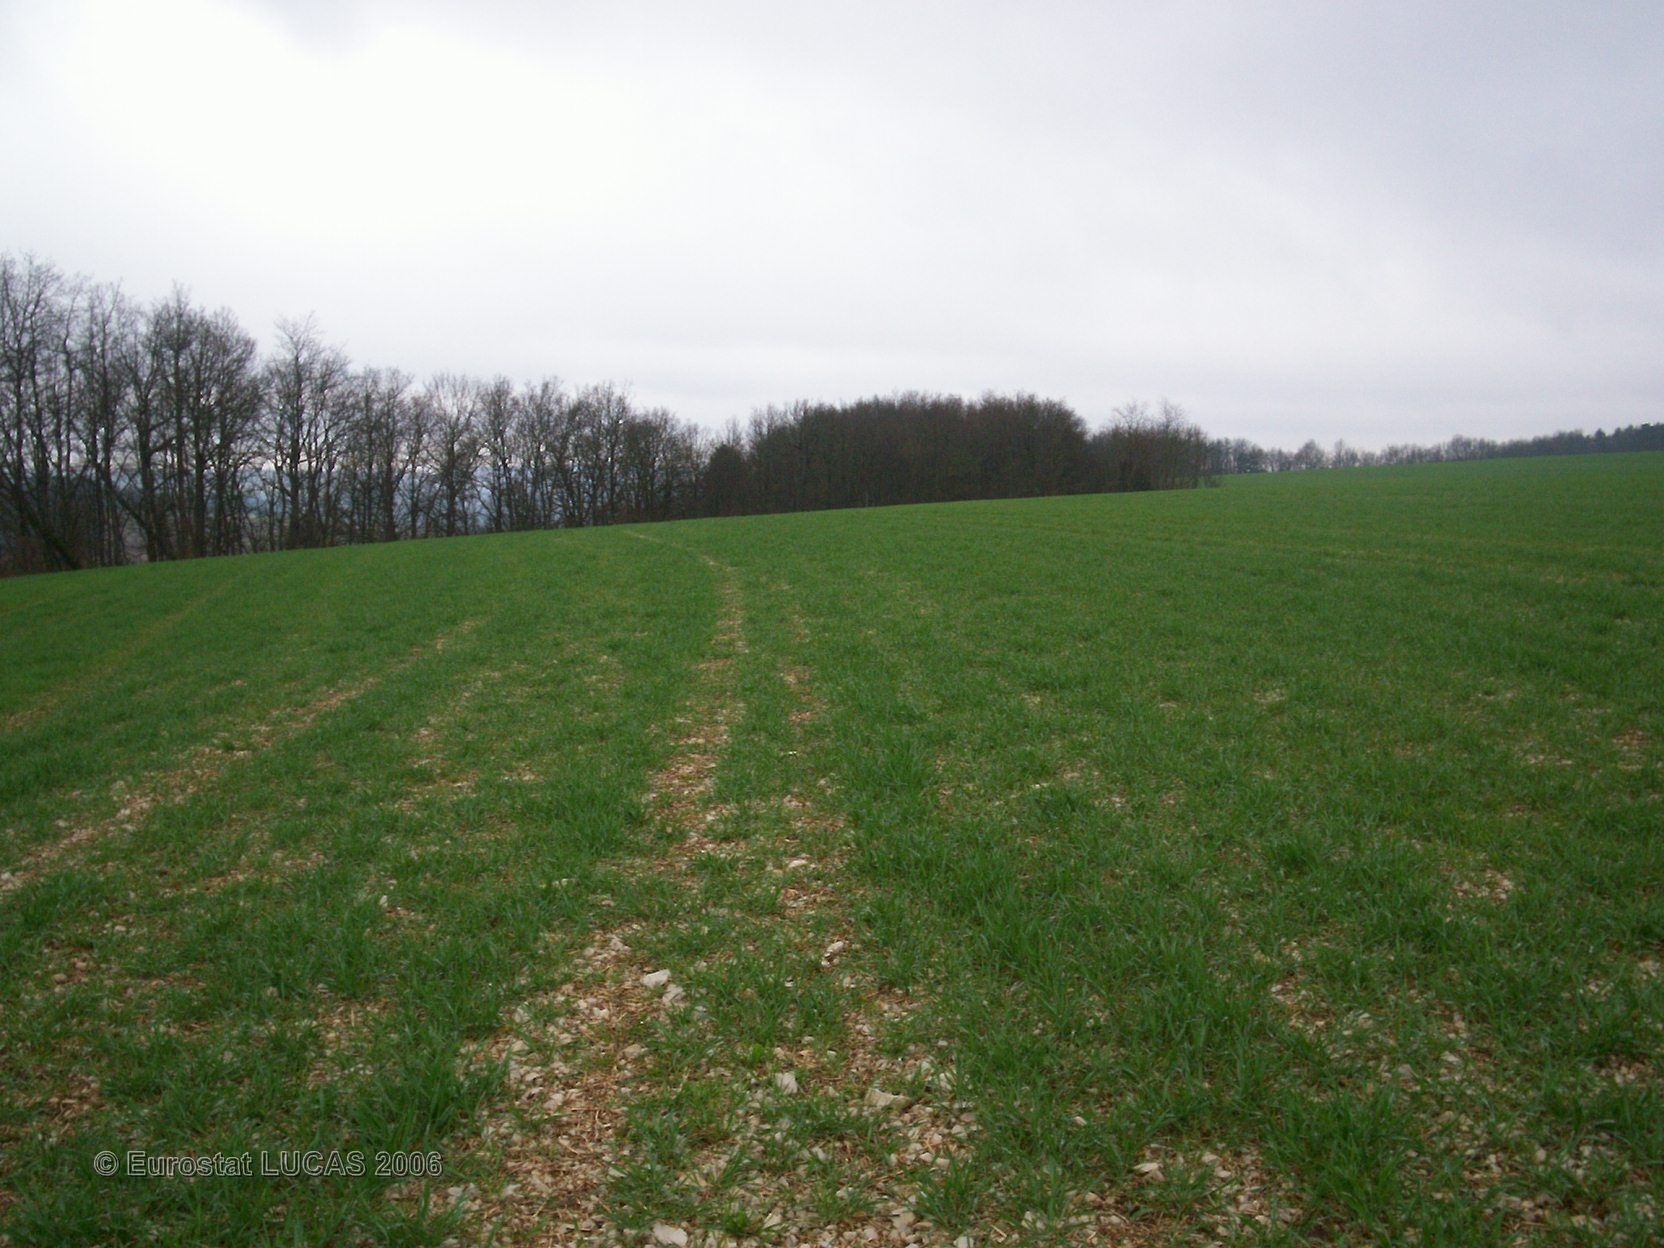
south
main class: Cropland
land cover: Common wheat
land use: Agriculture (excluding fallow land and kitchen gardens)
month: April
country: FR
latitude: 48.1032
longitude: 4.4784
